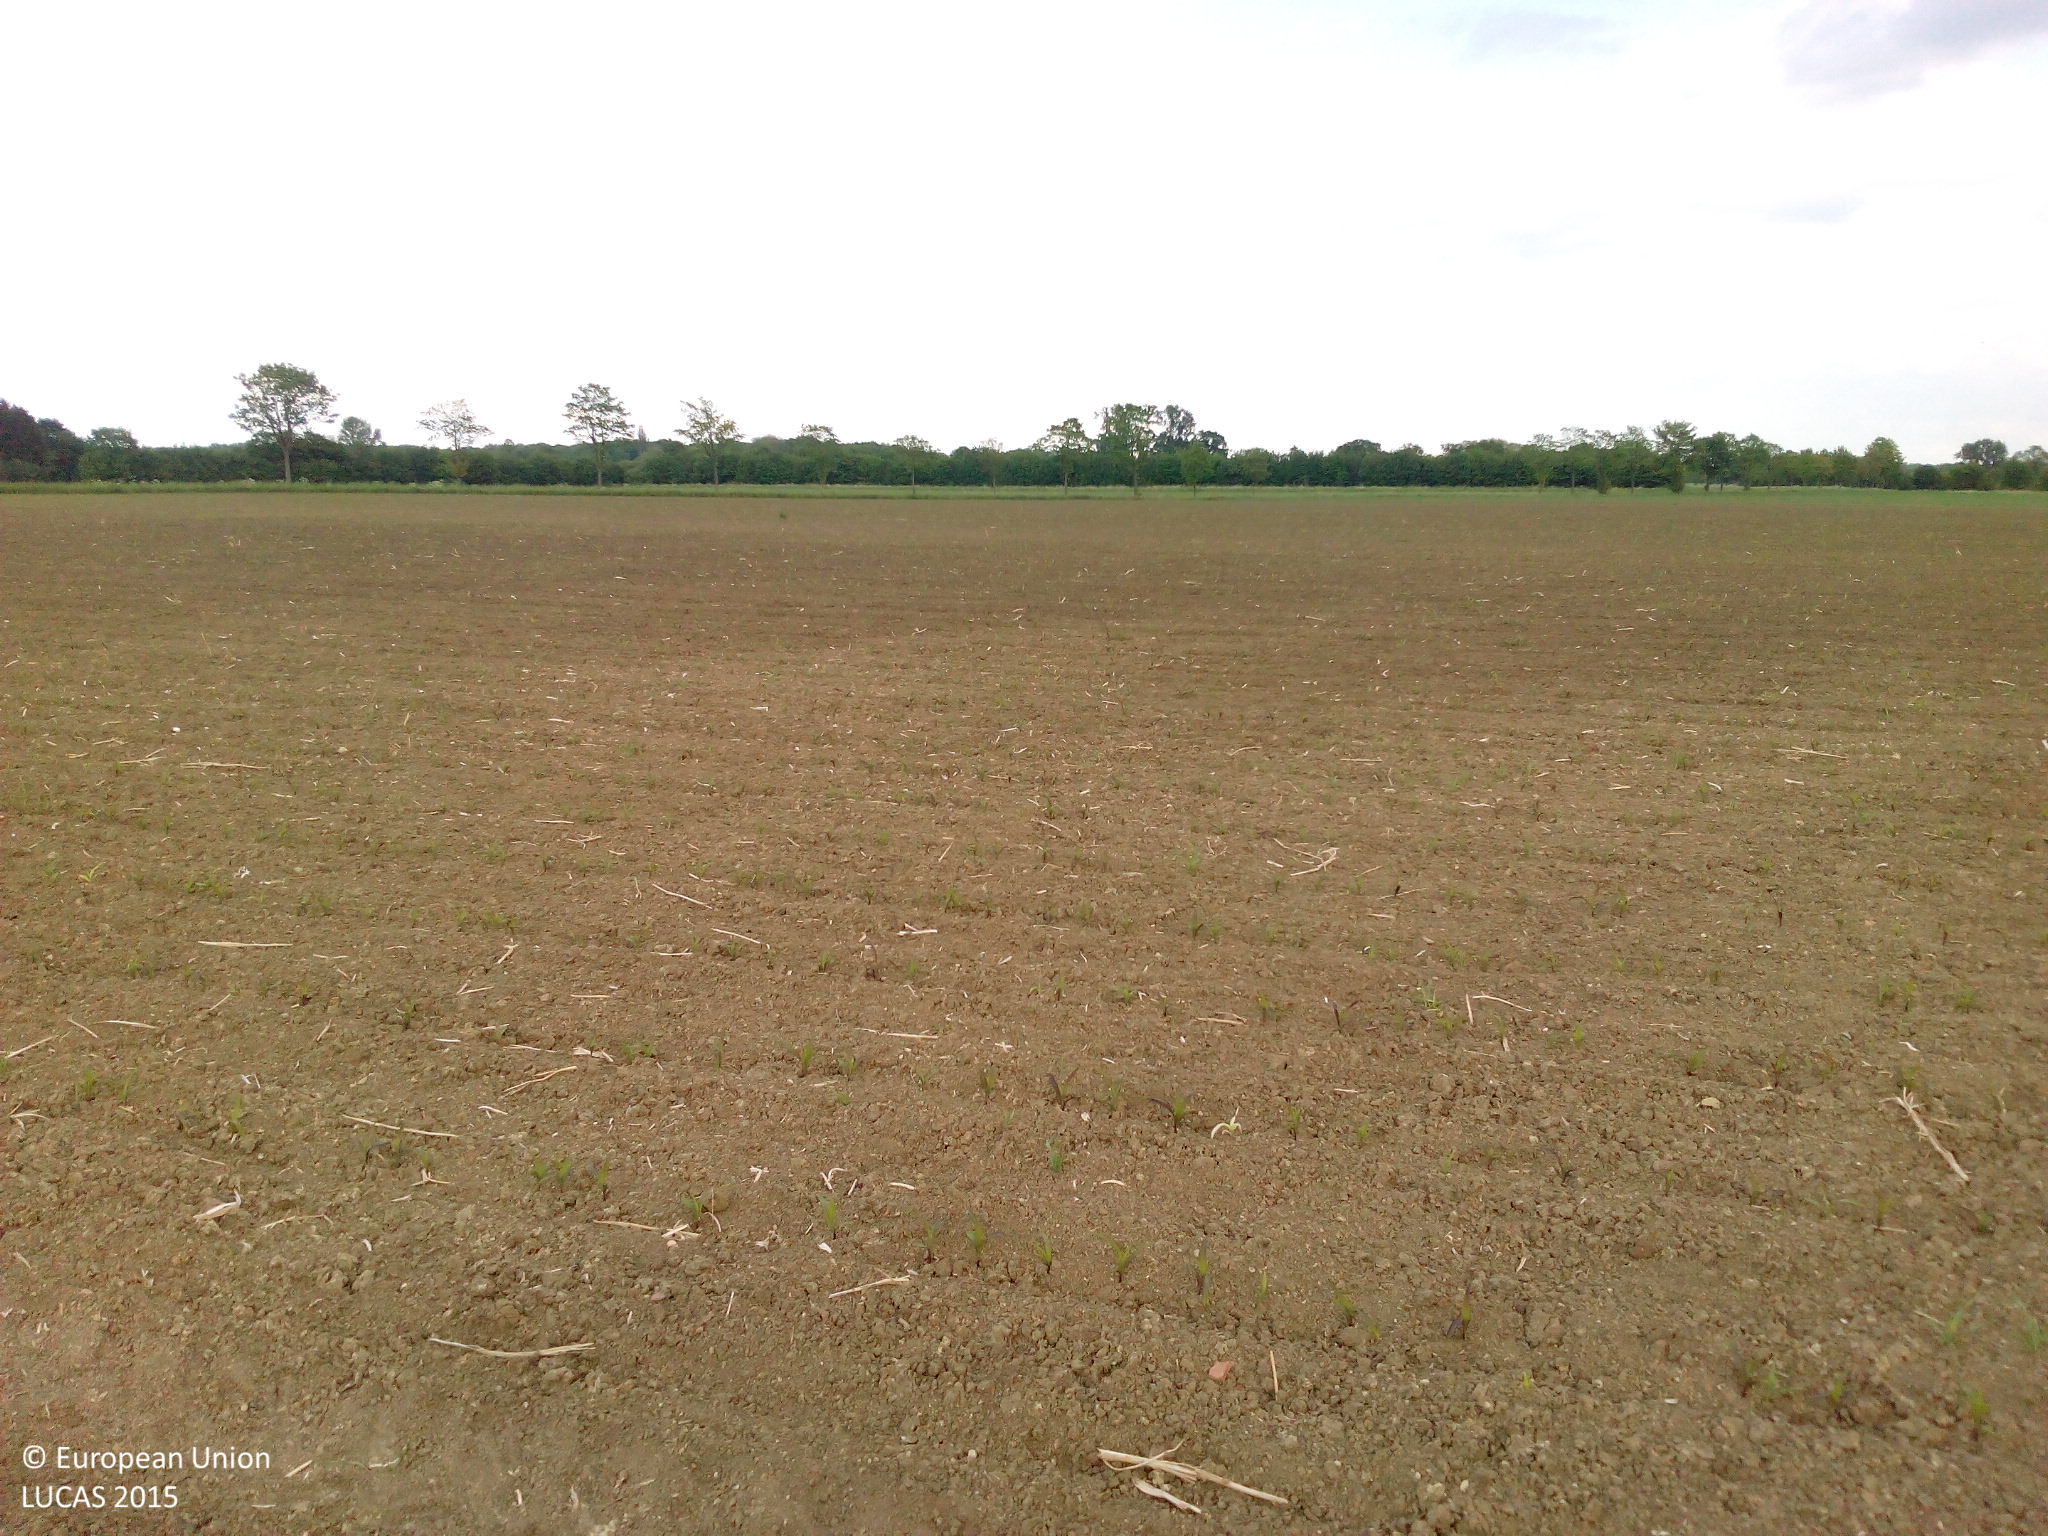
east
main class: Cropland
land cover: Maize
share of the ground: < 10 %
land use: Agriculture (excluding fallow land and kitchen gardens)
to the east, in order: Maize; Grass margins; Ditches and canals; Lines of trees; Grass margins; Paved roads, cycling and walking lanes; Grass margins; Ditches and canals; Grass margins; Oats
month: May
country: DE
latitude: 51.8025
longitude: 7.9556
